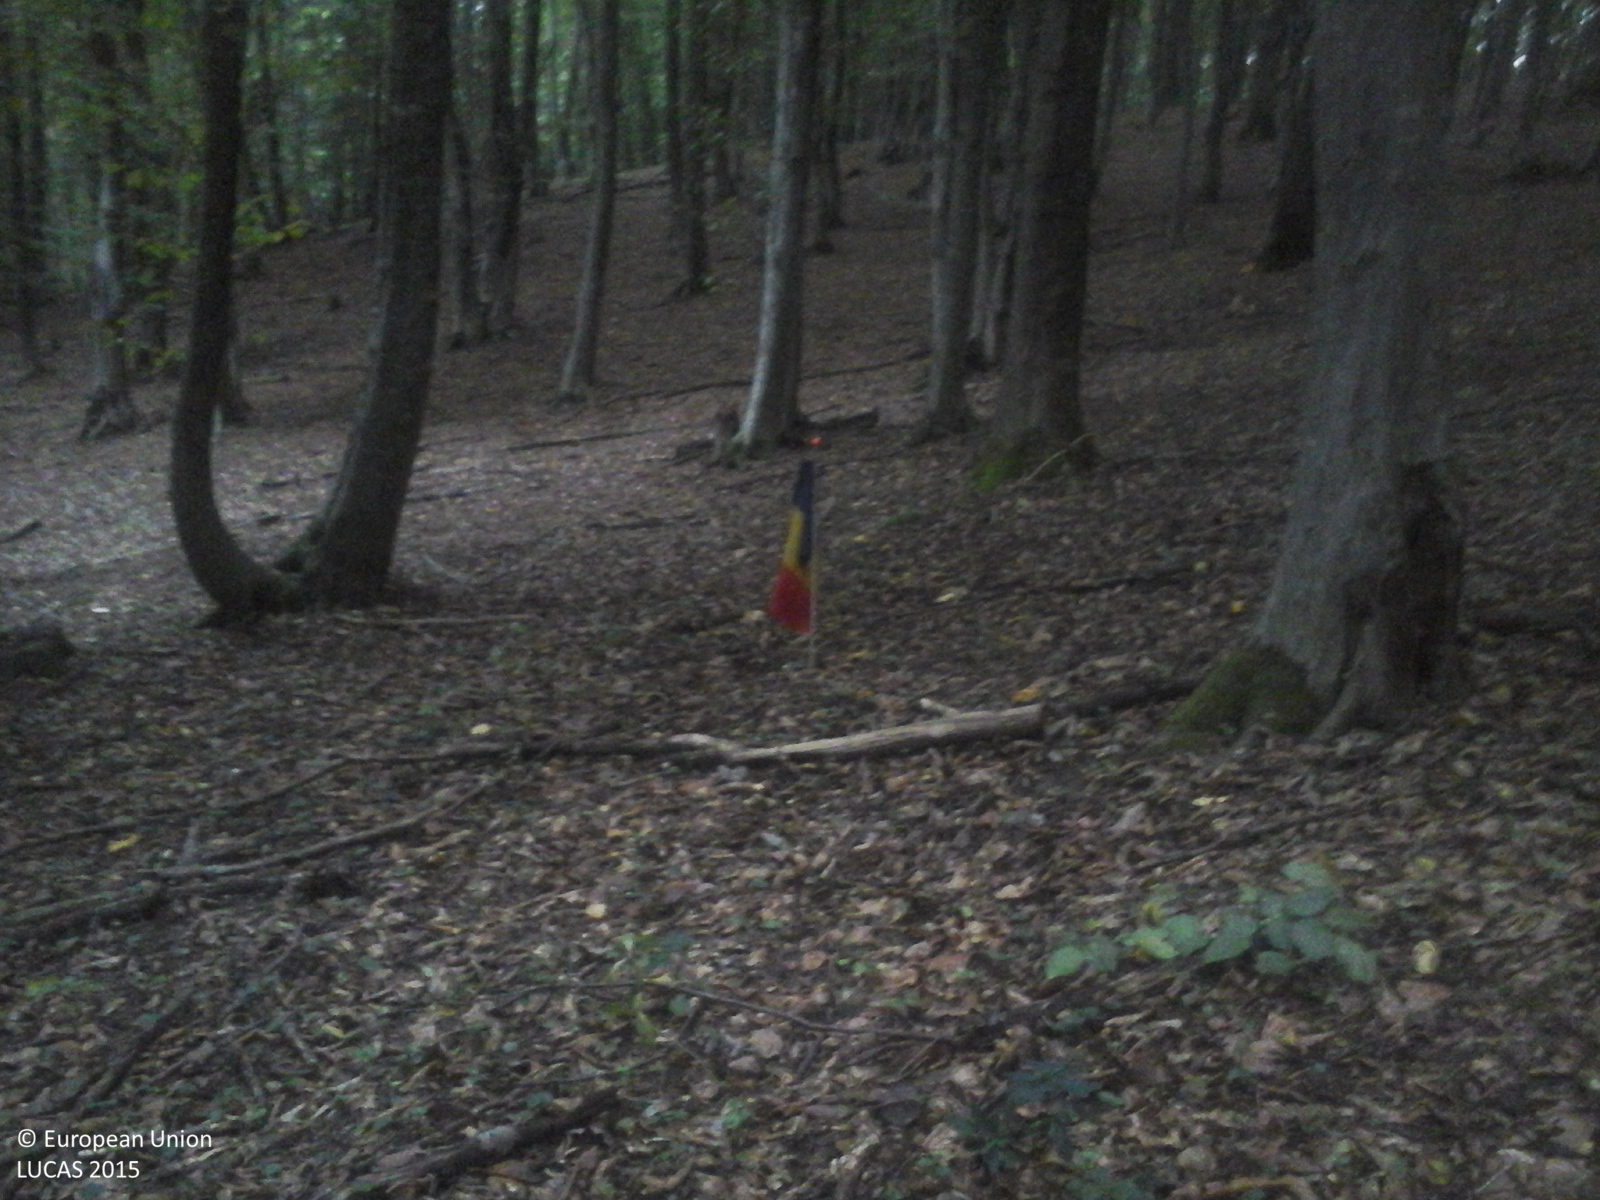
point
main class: Woodland
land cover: Broadleaved woodland
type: beech forest
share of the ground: > 75 %
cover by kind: broadleaved forest trees 100 %
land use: Forestry
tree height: > 5 m
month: October
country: RO
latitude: 46.4364
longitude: 24.7598
